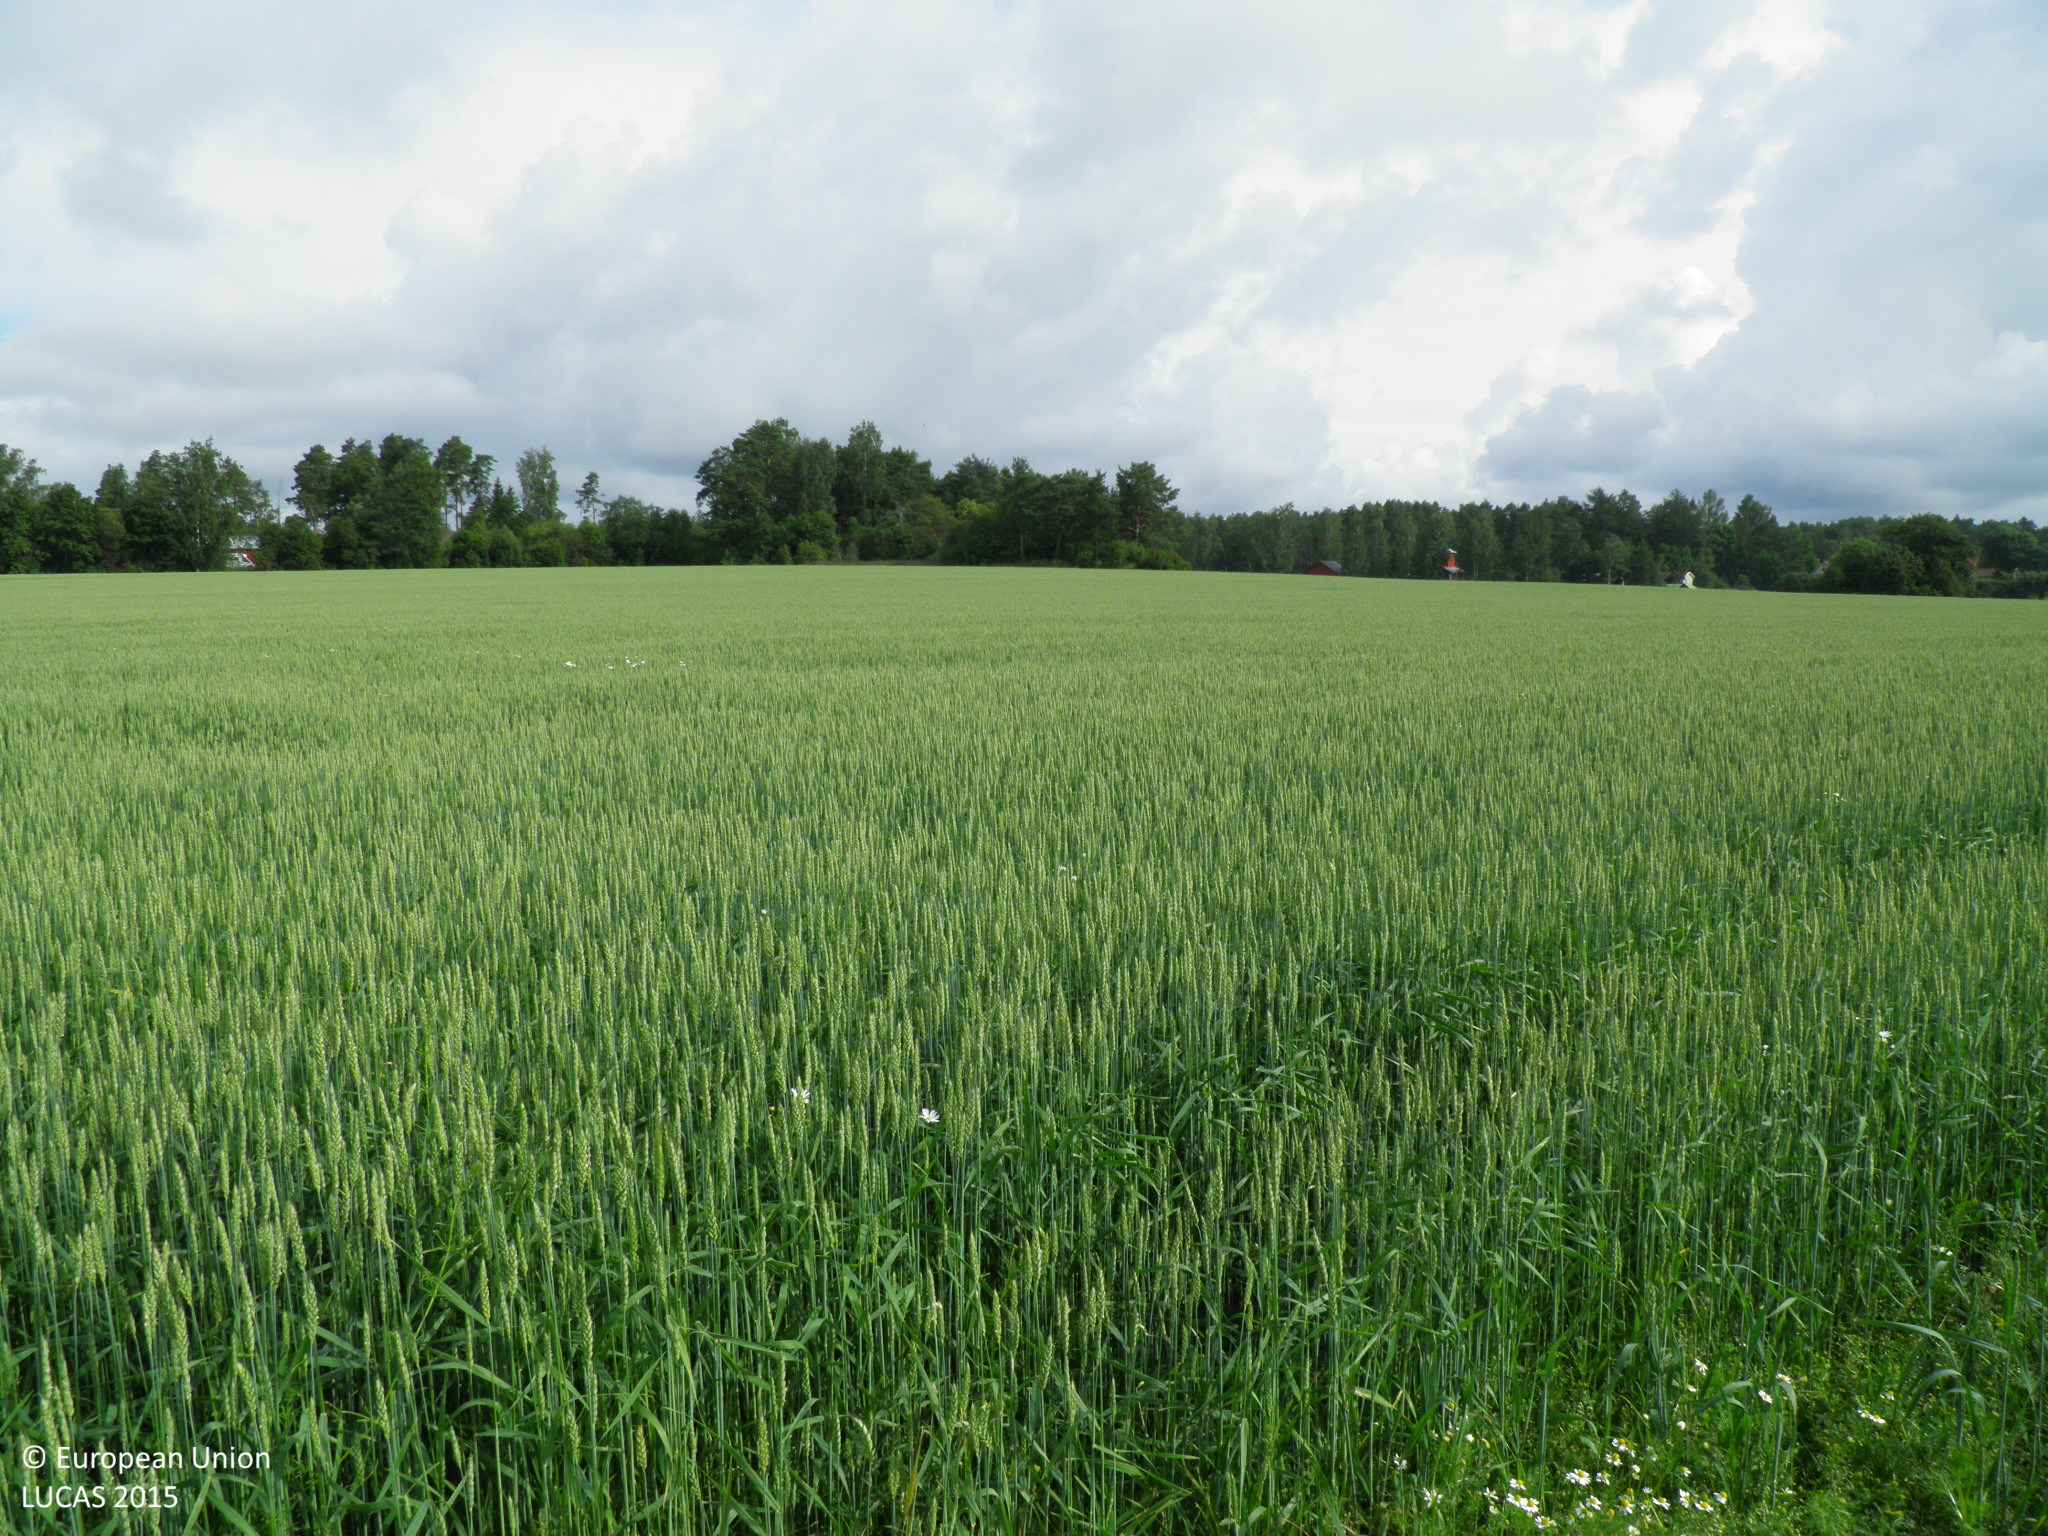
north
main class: Cropland
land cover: Common wheat
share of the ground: > 75 %
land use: Agriculture (excluding fallow land and kitchen gardens)
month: July
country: FI
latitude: 60.6867
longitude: 21.5740
